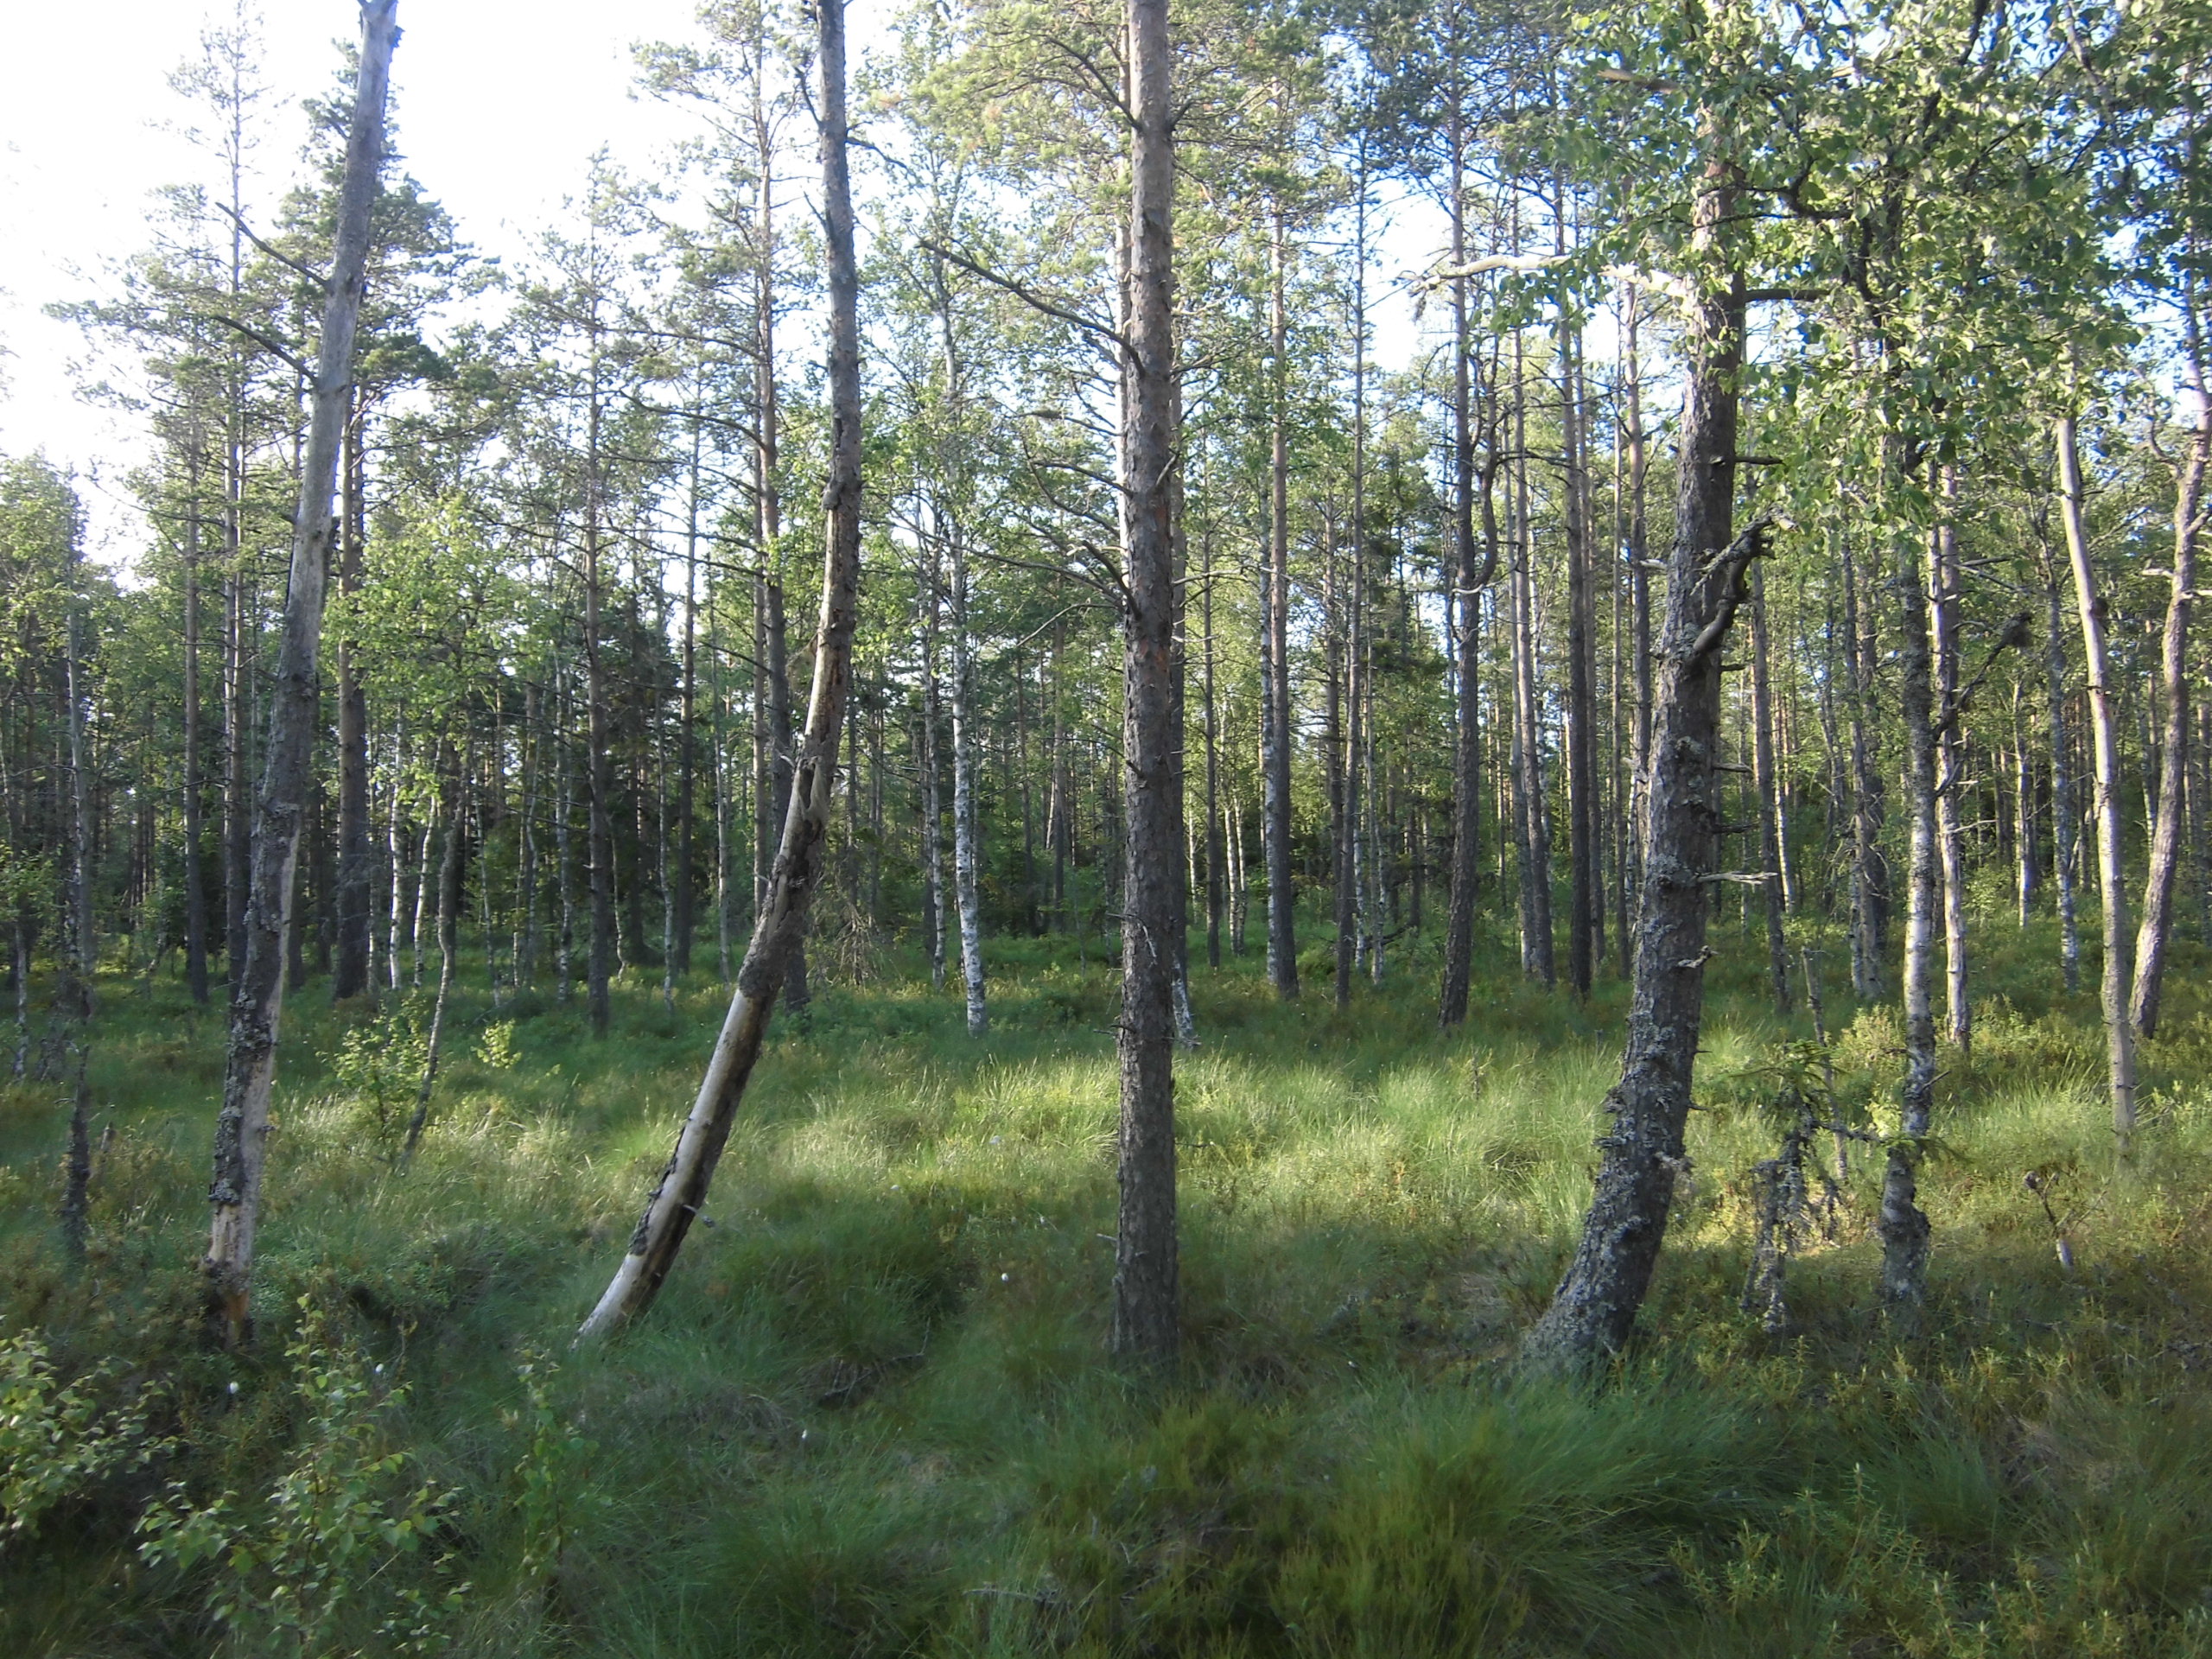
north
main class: Woodland
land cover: Pine dominated coniferous woodland
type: boreal forest
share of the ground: 50 - 75 %
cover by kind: coniferous forest trees 50 %, shrubs 15 %, herbaceous plants 15 %, lichens and mosses 15 %, broadleaved forest trees 5 %
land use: Forestry
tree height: > 5 m
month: July
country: SE
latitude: 57.1800
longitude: 15.2411
